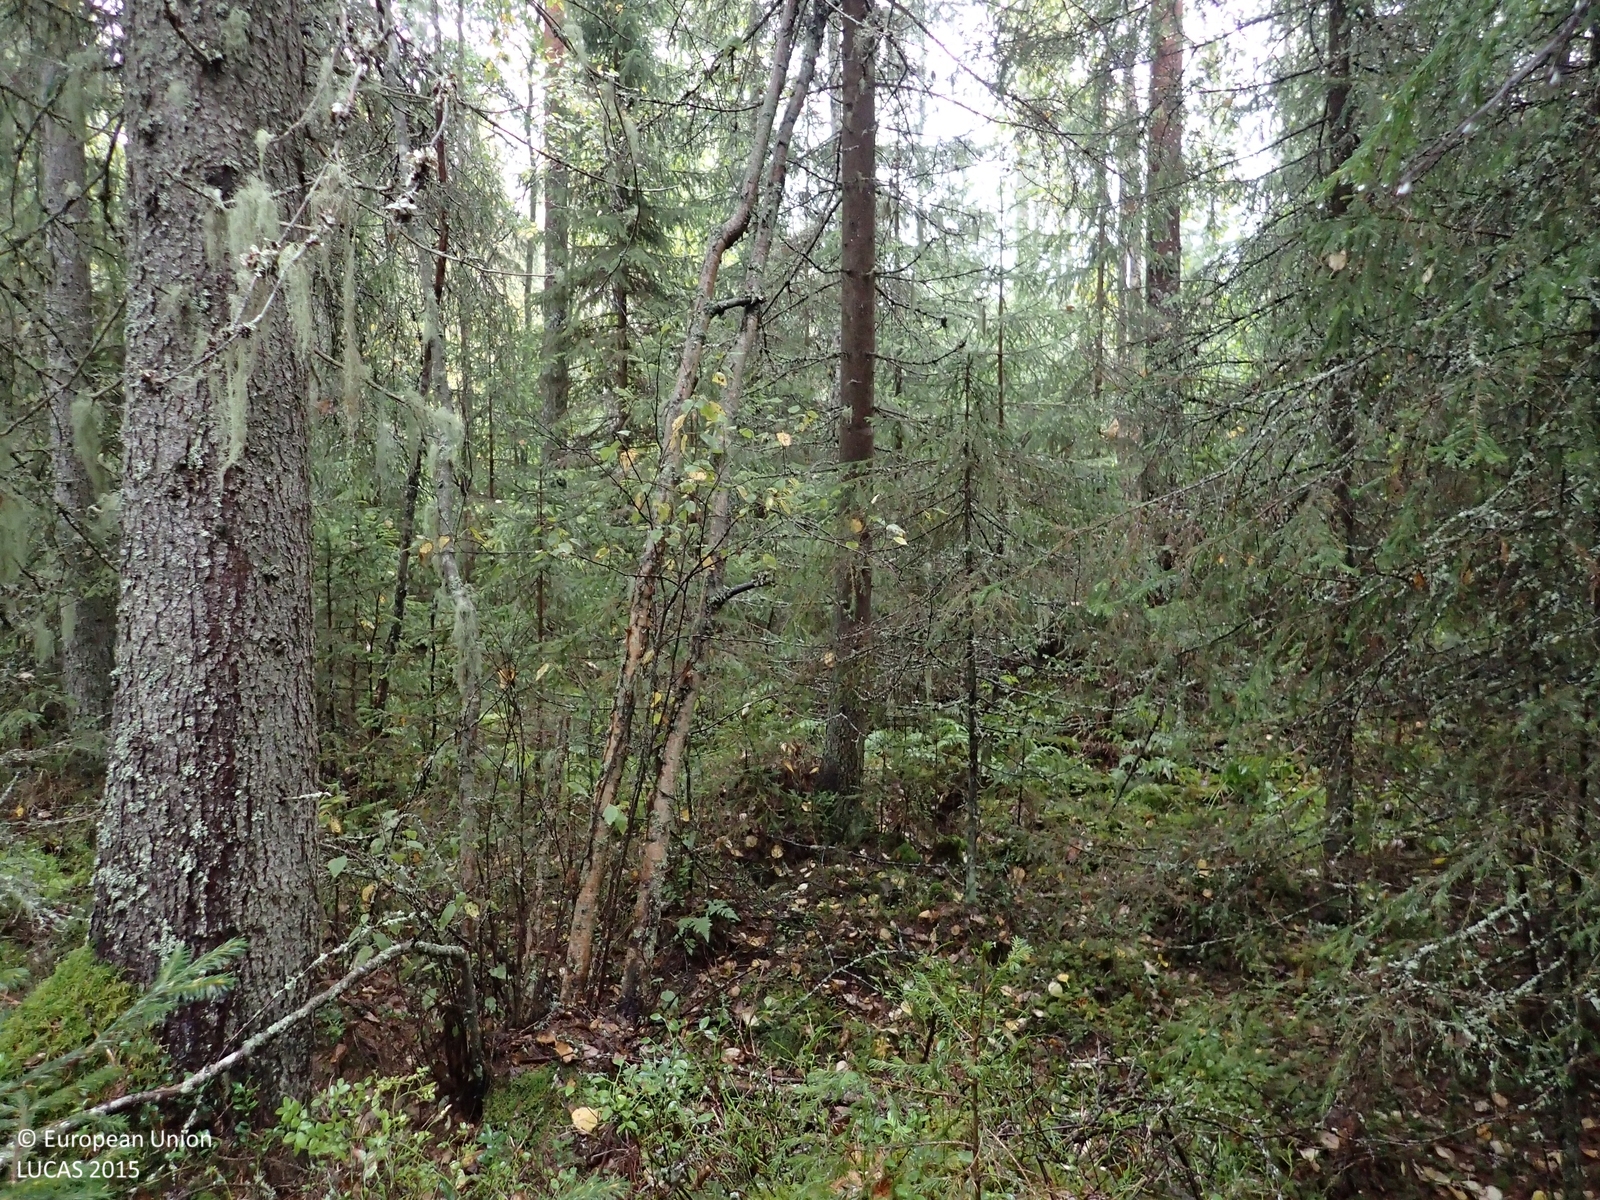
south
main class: Woodland
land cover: Spruce dominated coniferous woodland
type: boreal forest
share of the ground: > 75 %
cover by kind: coniferous forest trees 70 %, broadleaved forest trees 10 %, shrubs 10 %, lichens and mosses 10 %
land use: Forestry
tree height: > 5 m
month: September
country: FI
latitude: 63.1523
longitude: 26.1782
